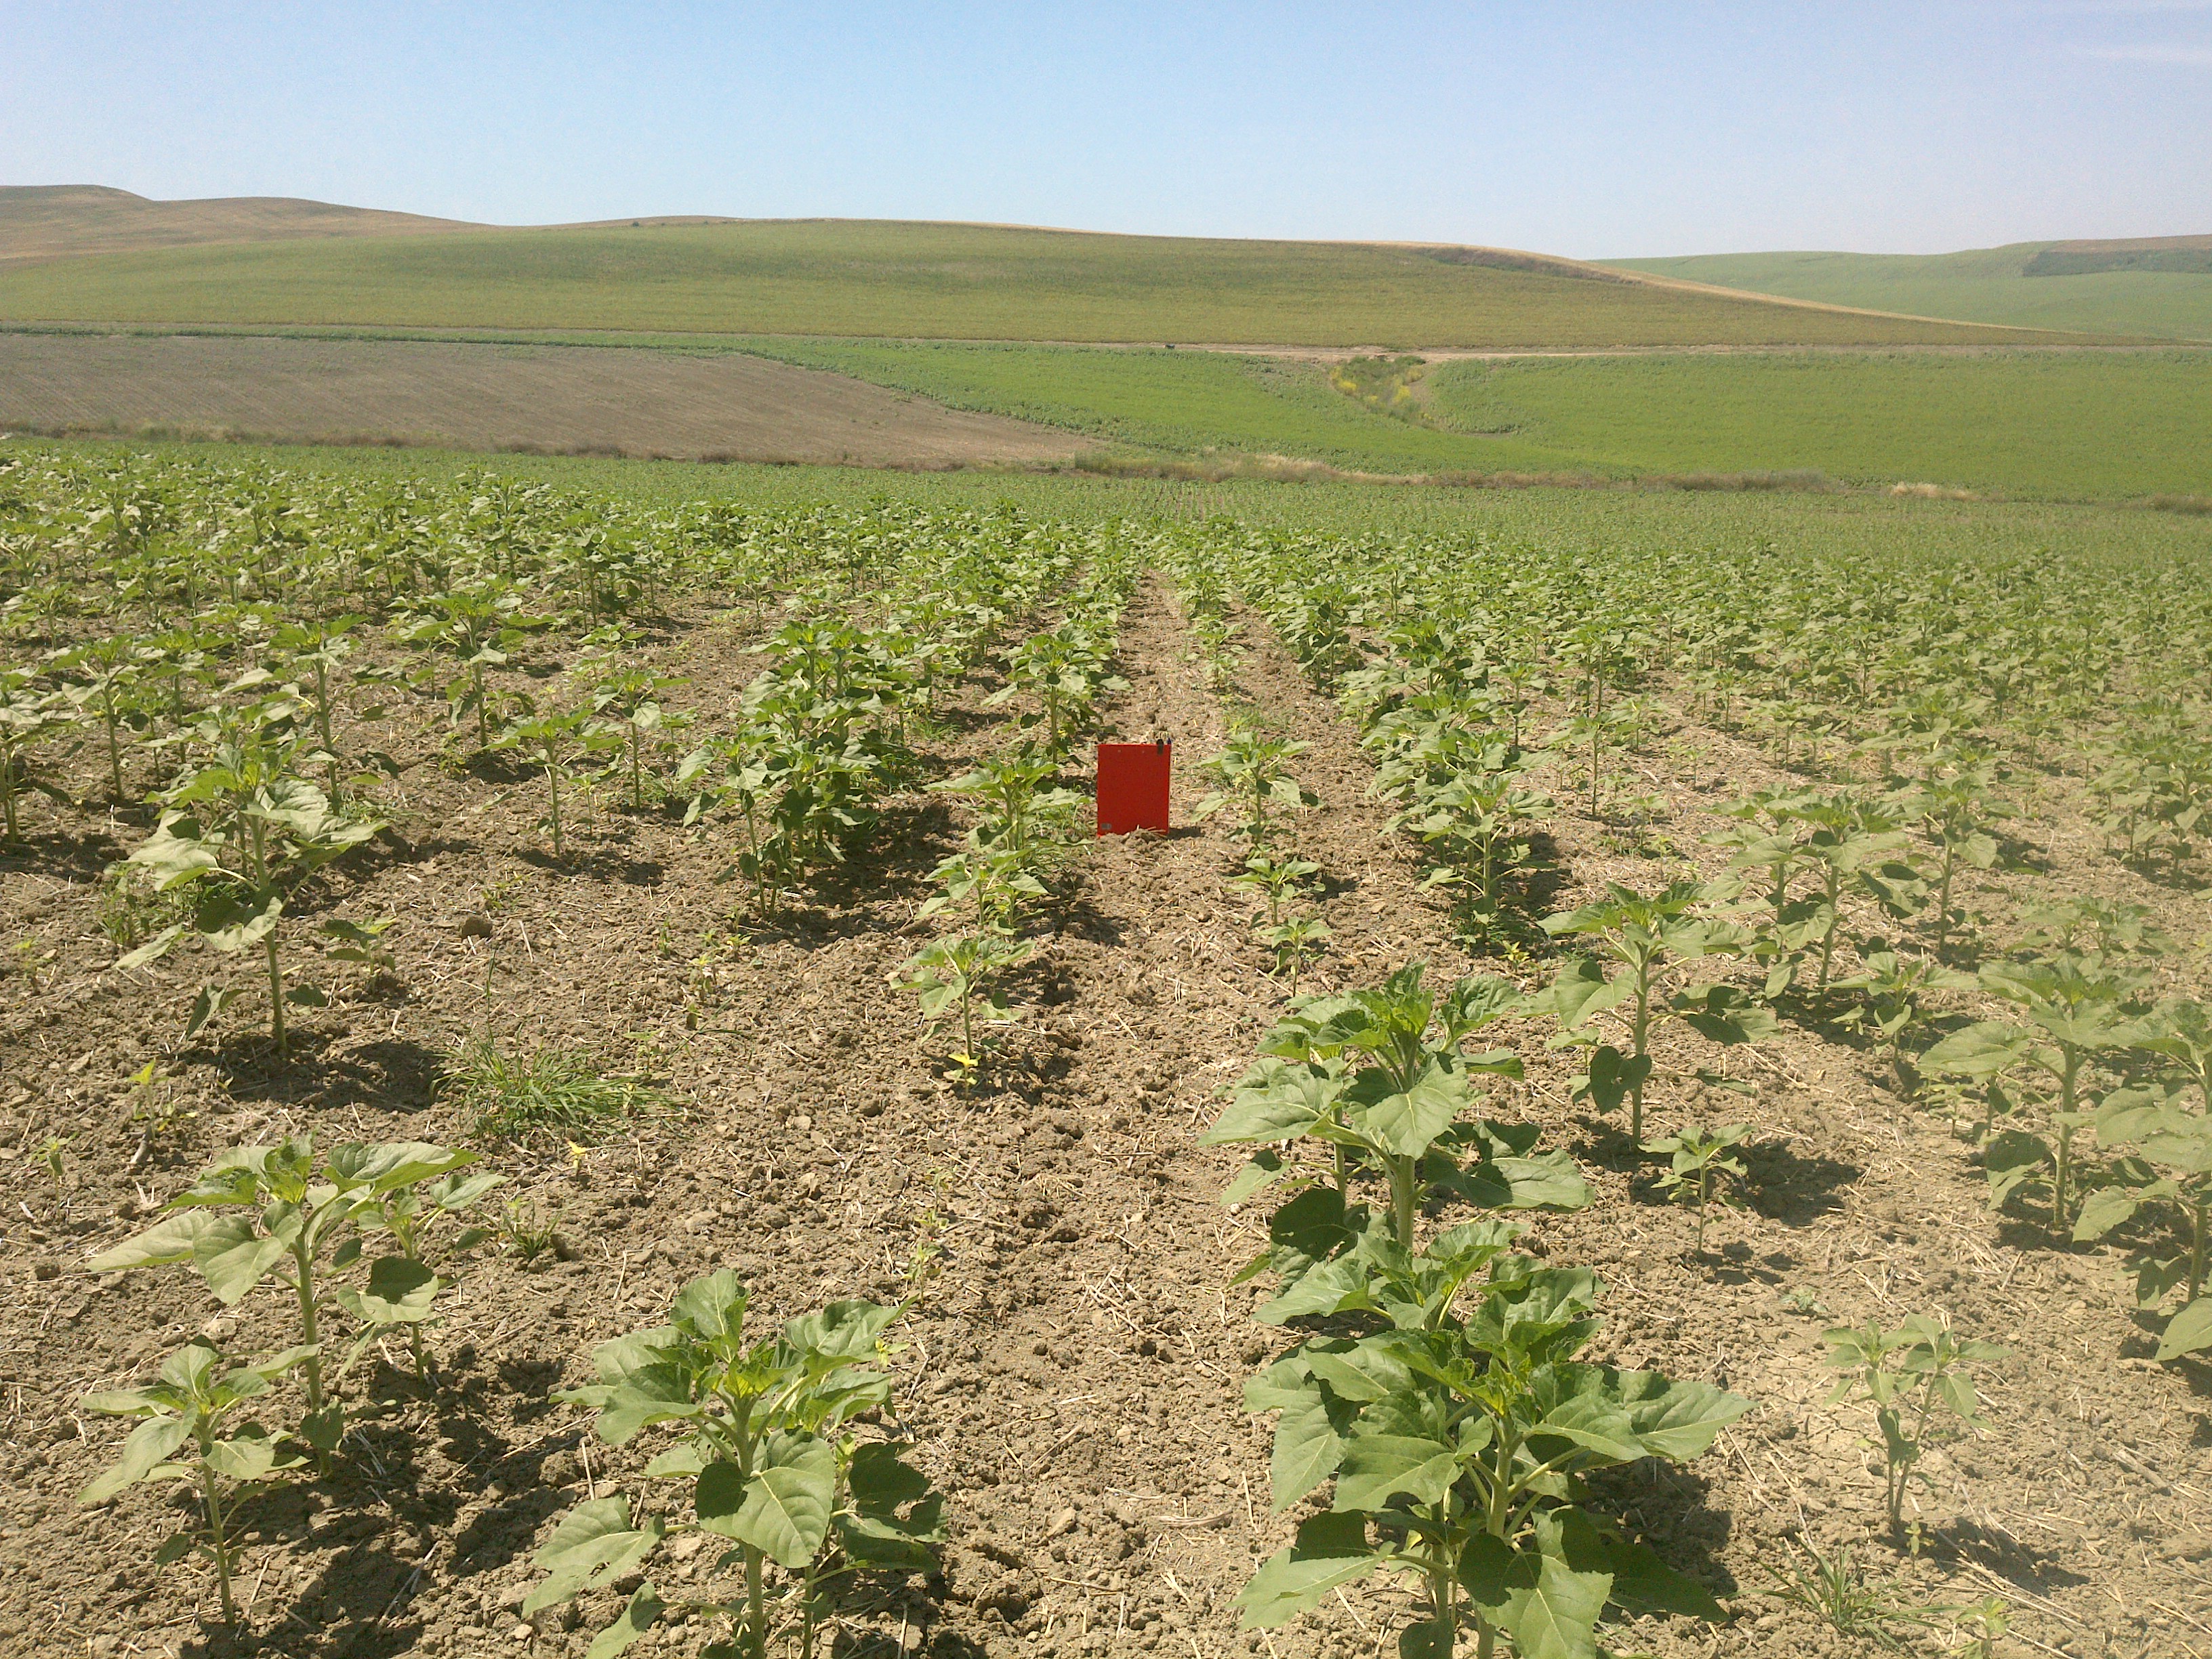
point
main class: Cropland
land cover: Sunflower
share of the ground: > 75 %
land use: Agriculture (excluding fallow land and kitchen gardens)
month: May
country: ES
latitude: 37.8548
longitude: -4.6625
